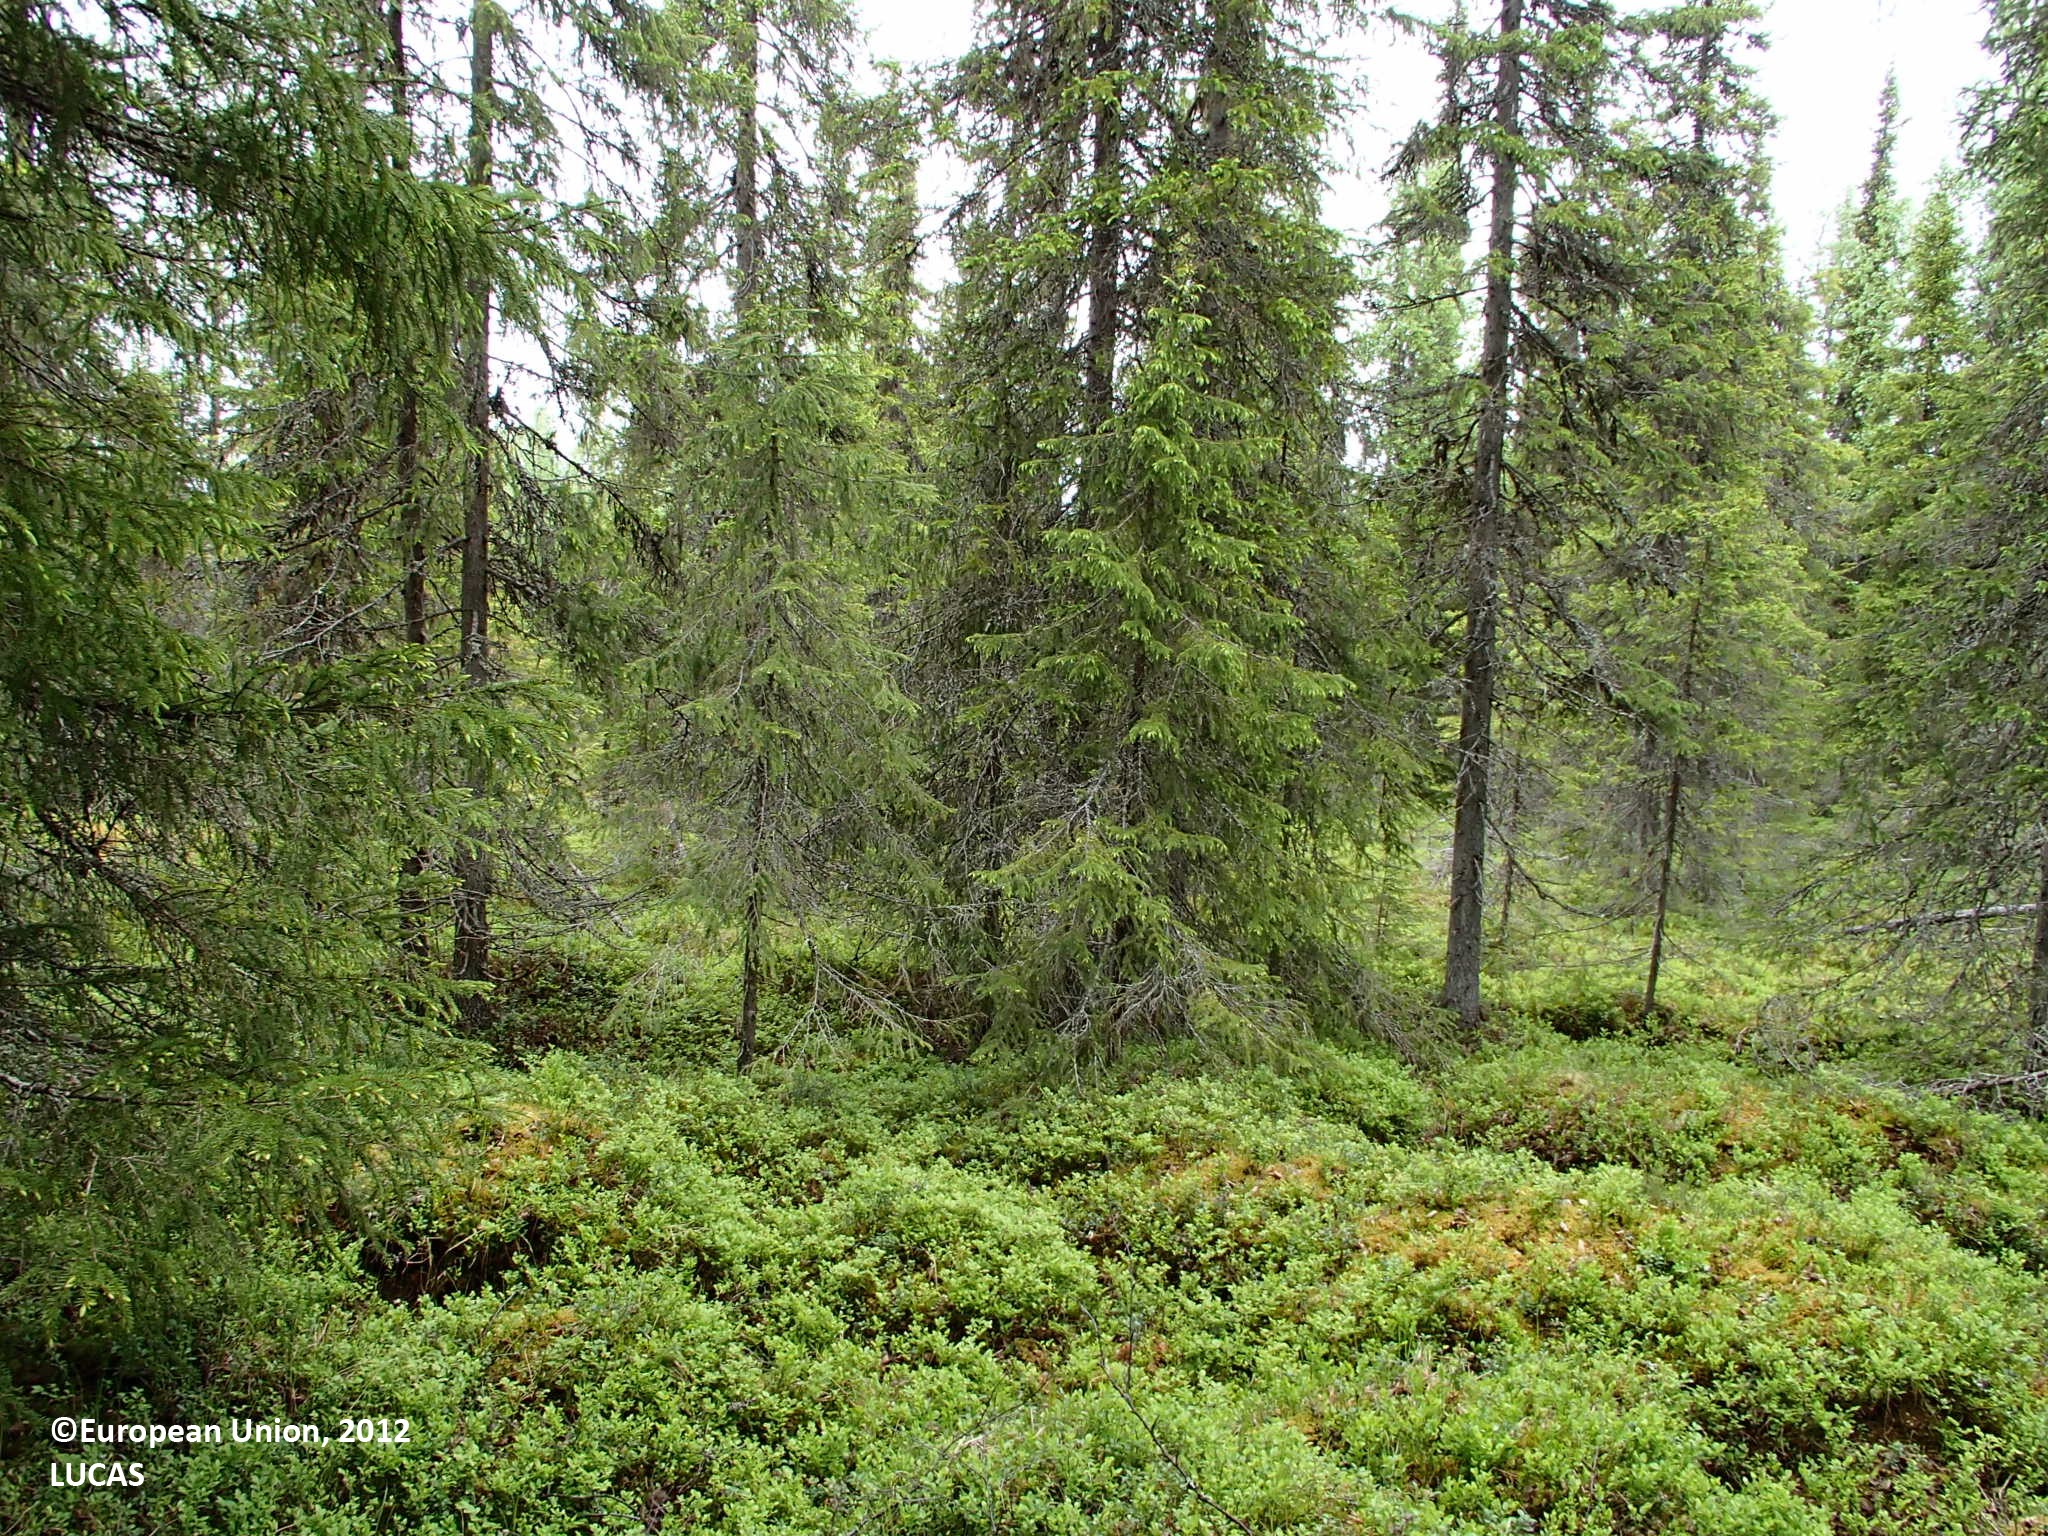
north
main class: Woodland
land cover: Spruce dominated mixed woodland
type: boreal forest
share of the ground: > 75 %
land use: Forestry
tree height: > 5 m
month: June
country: FI
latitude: 66.4421
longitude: 27.5844
